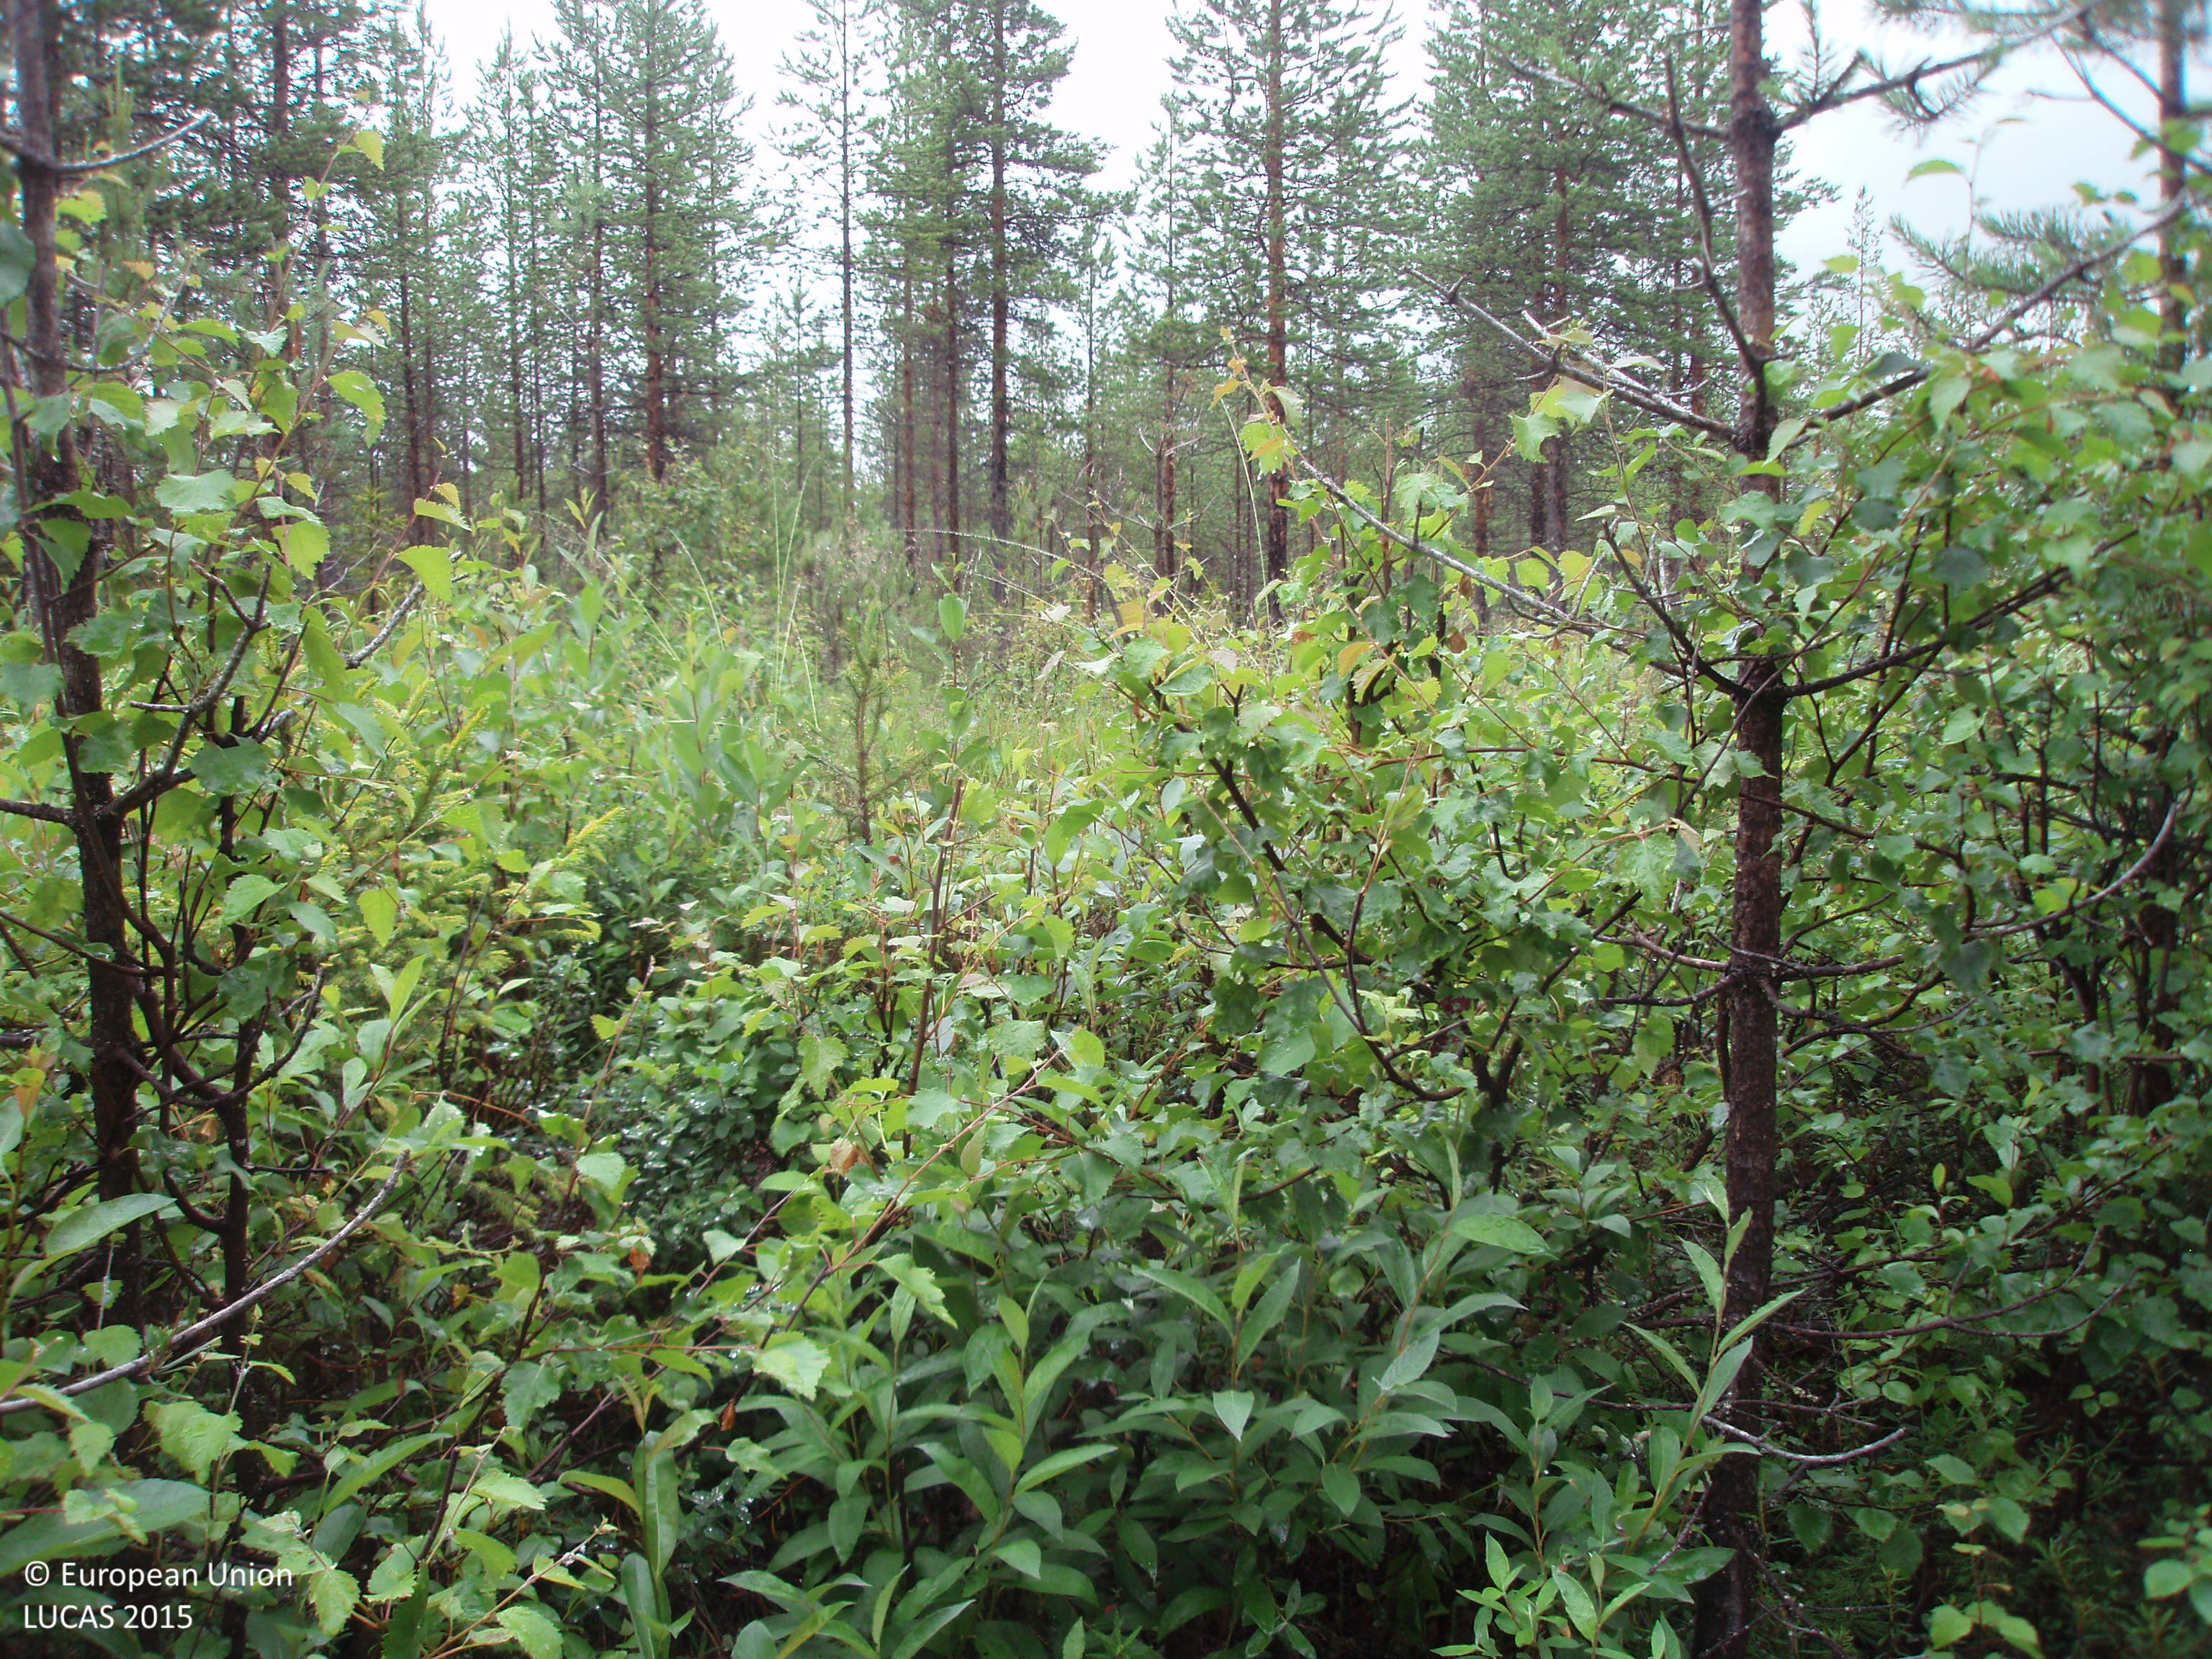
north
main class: Woodland
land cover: Pine dominated coniferous woodland
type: boreal forest
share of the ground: 50 - 75 %
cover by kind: shrubs 50 %, coniferous forest trees 45 %, broadleaved forest trees 5 %
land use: Forestry
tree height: > 5 m
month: July
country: FI
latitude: 66.6405
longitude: 28.0050
